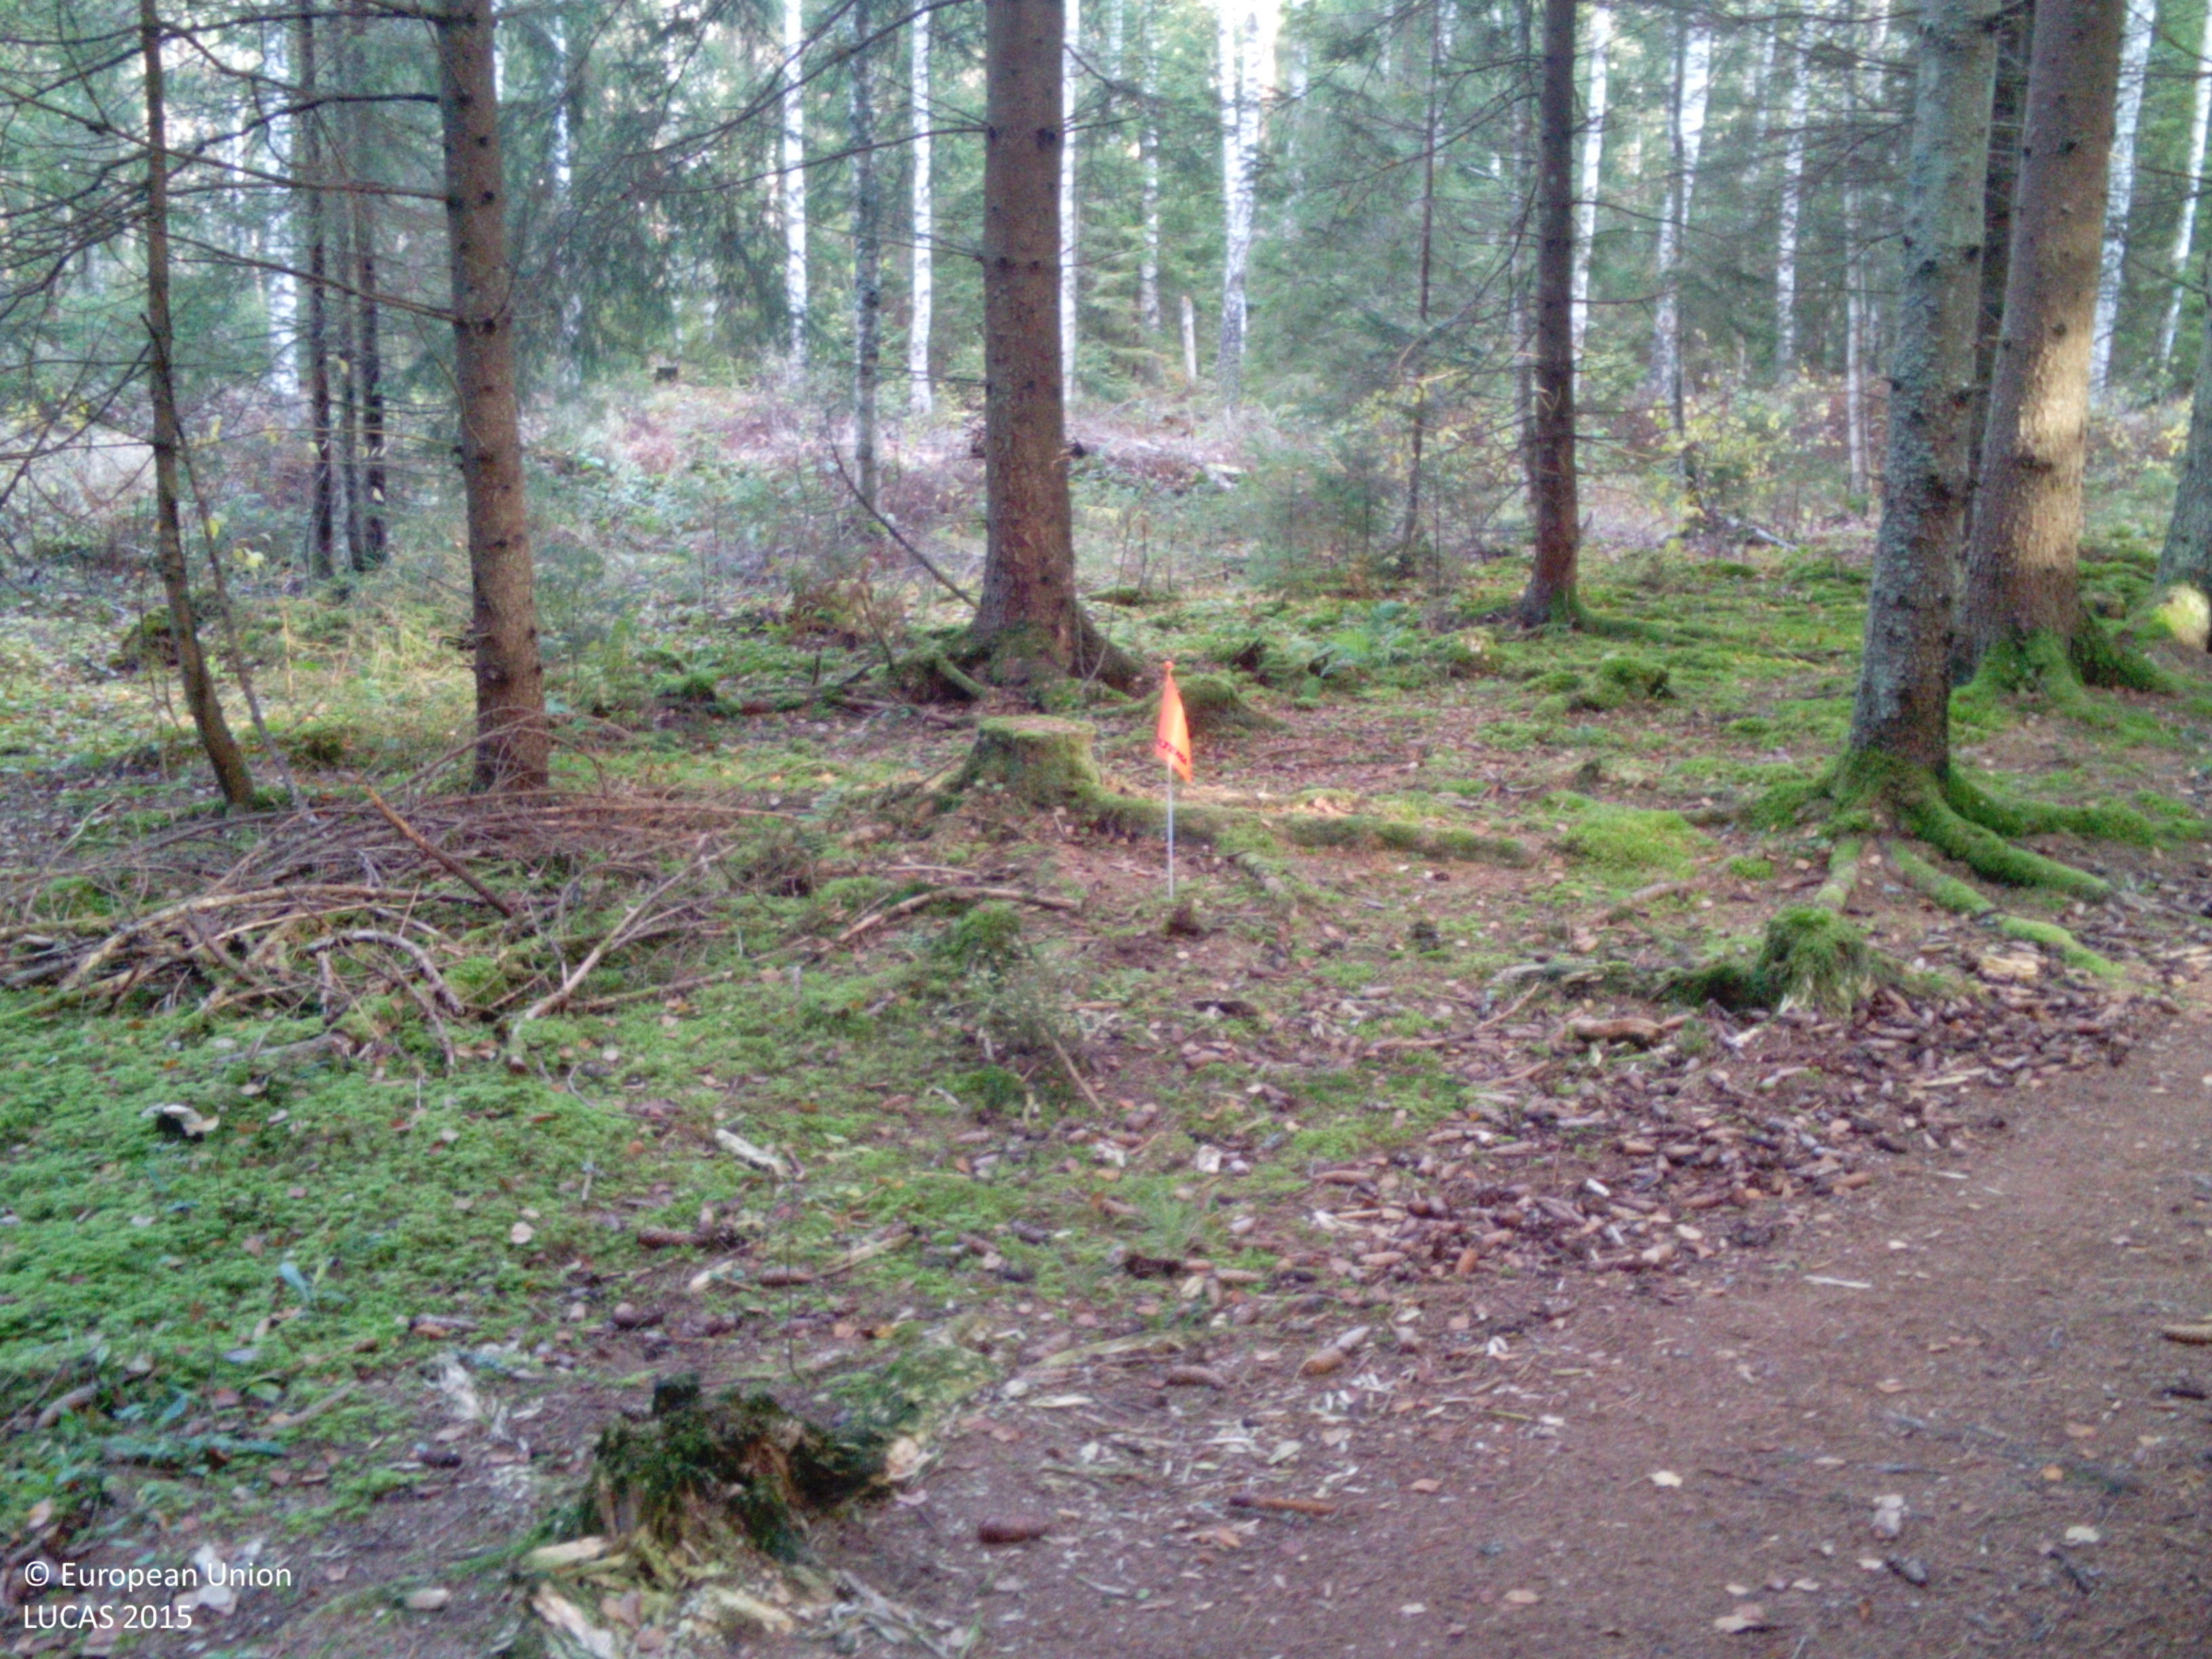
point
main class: Woodland
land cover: Spruce dominated coniferous woodland
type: boreal forest
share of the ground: > 75 %
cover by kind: coniferous forest trees 90 %, lichens and mosses 10 %
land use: Forestry
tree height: > 5 m
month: October
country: SE
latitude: 59.0130
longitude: 16.2454
